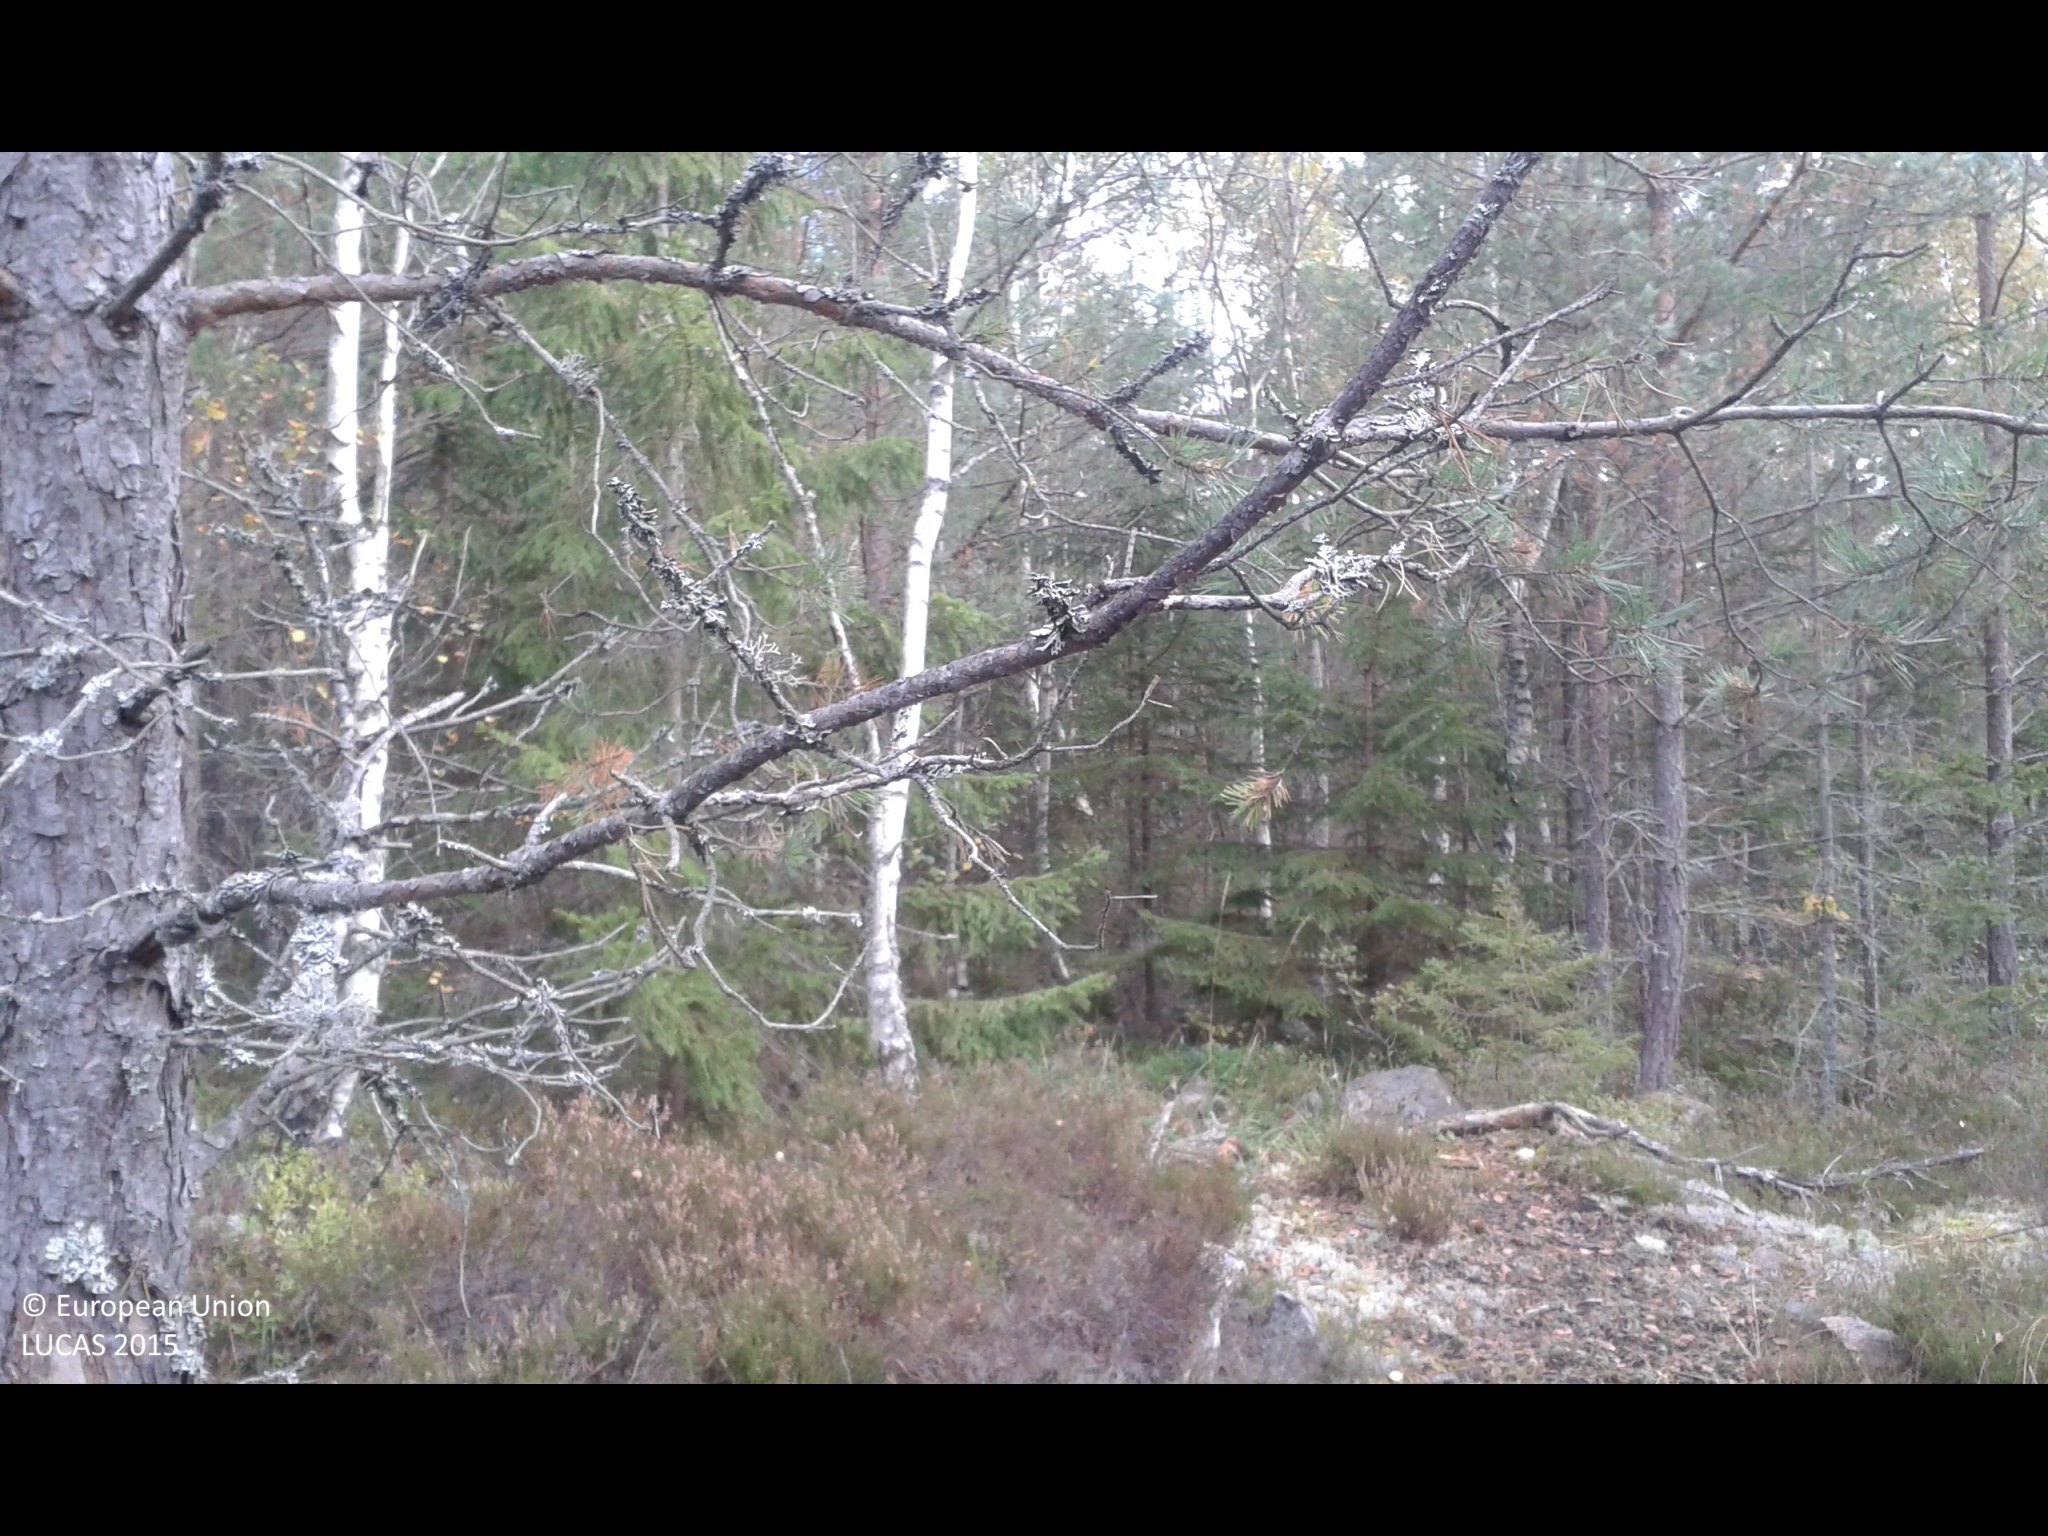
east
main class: Woodland
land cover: Pine dominated coniferous woodland
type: boreal forest
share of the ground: > 75 %
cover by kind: coniferous forest trees 75 %, herbaceous plants 15 %, broadleaved forest trees 10 %
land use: Forestry
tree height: > 5 m
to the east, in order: Pine dominated coniferous woodland
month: September
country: SE
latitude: 59.0832
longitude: 17.3779
